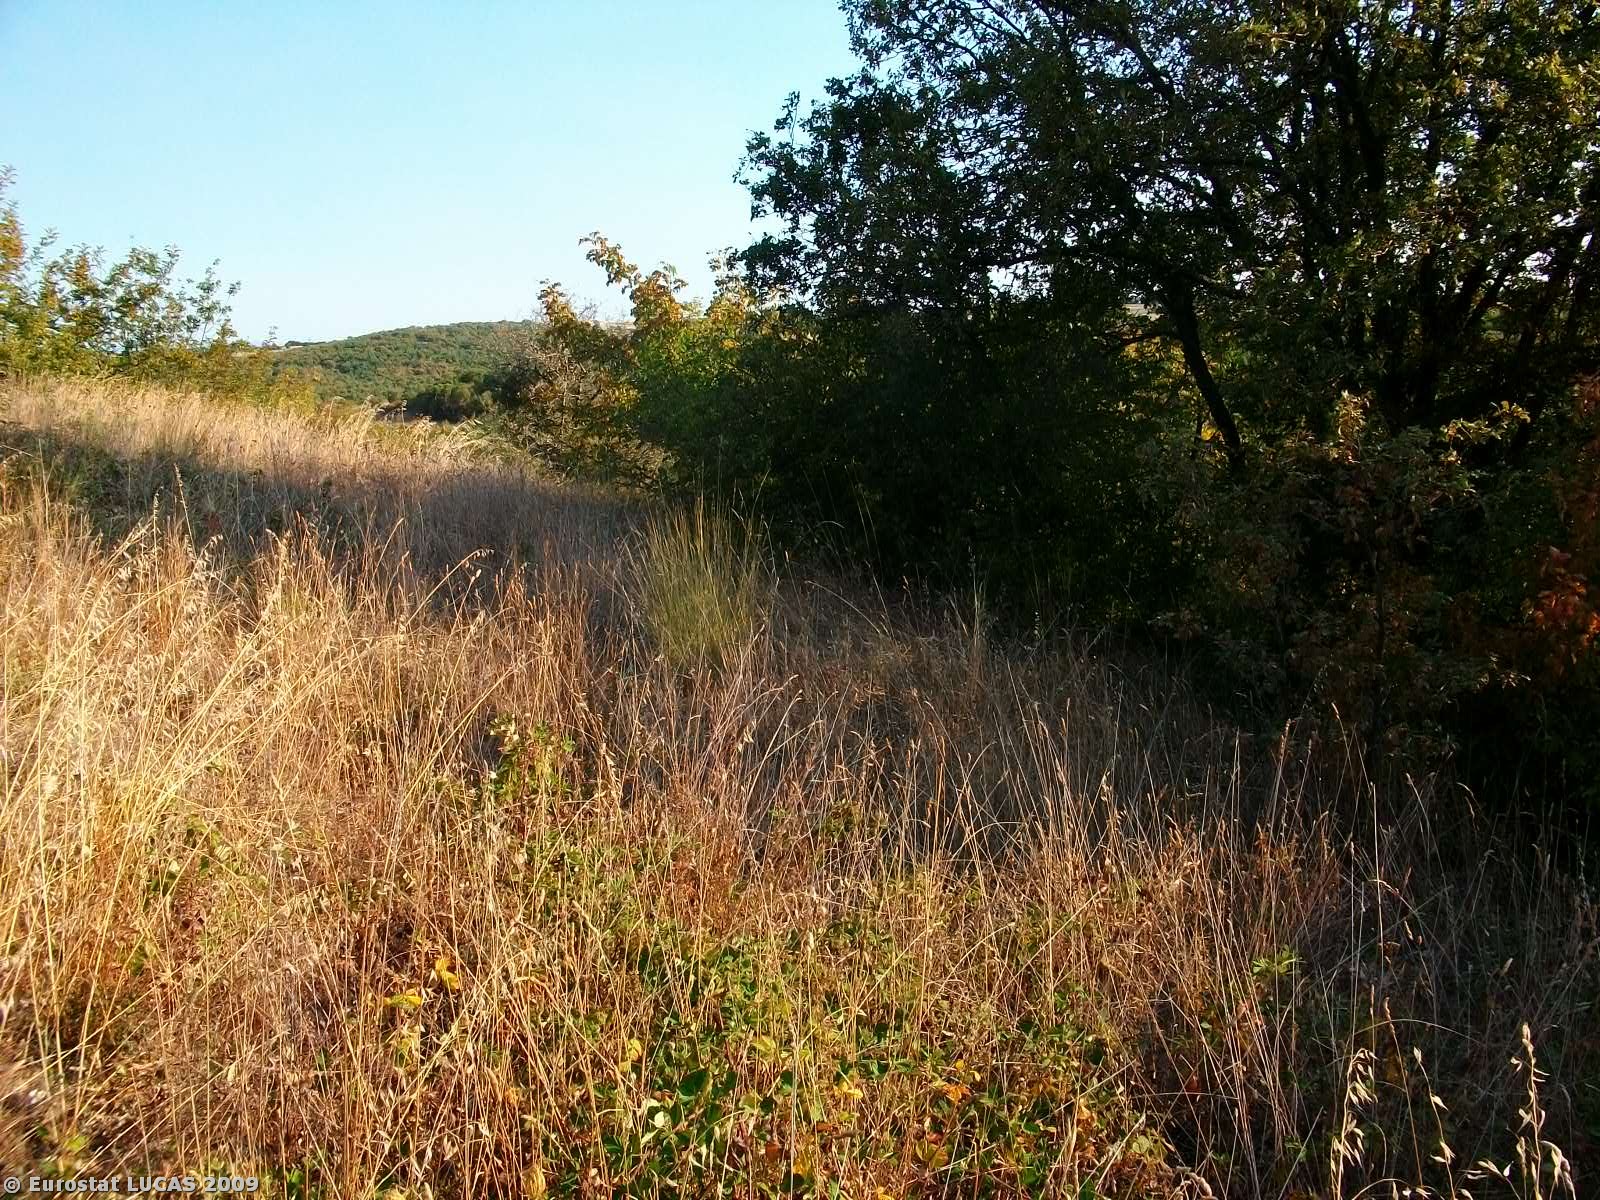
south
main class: Woodland
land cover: Broadleaved woodland
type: thermophilous deciduous forest
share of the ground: > 75 %
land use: Forestry
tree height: > 5 m
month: August
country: GR
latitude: 41.3240
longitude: 26.4059
